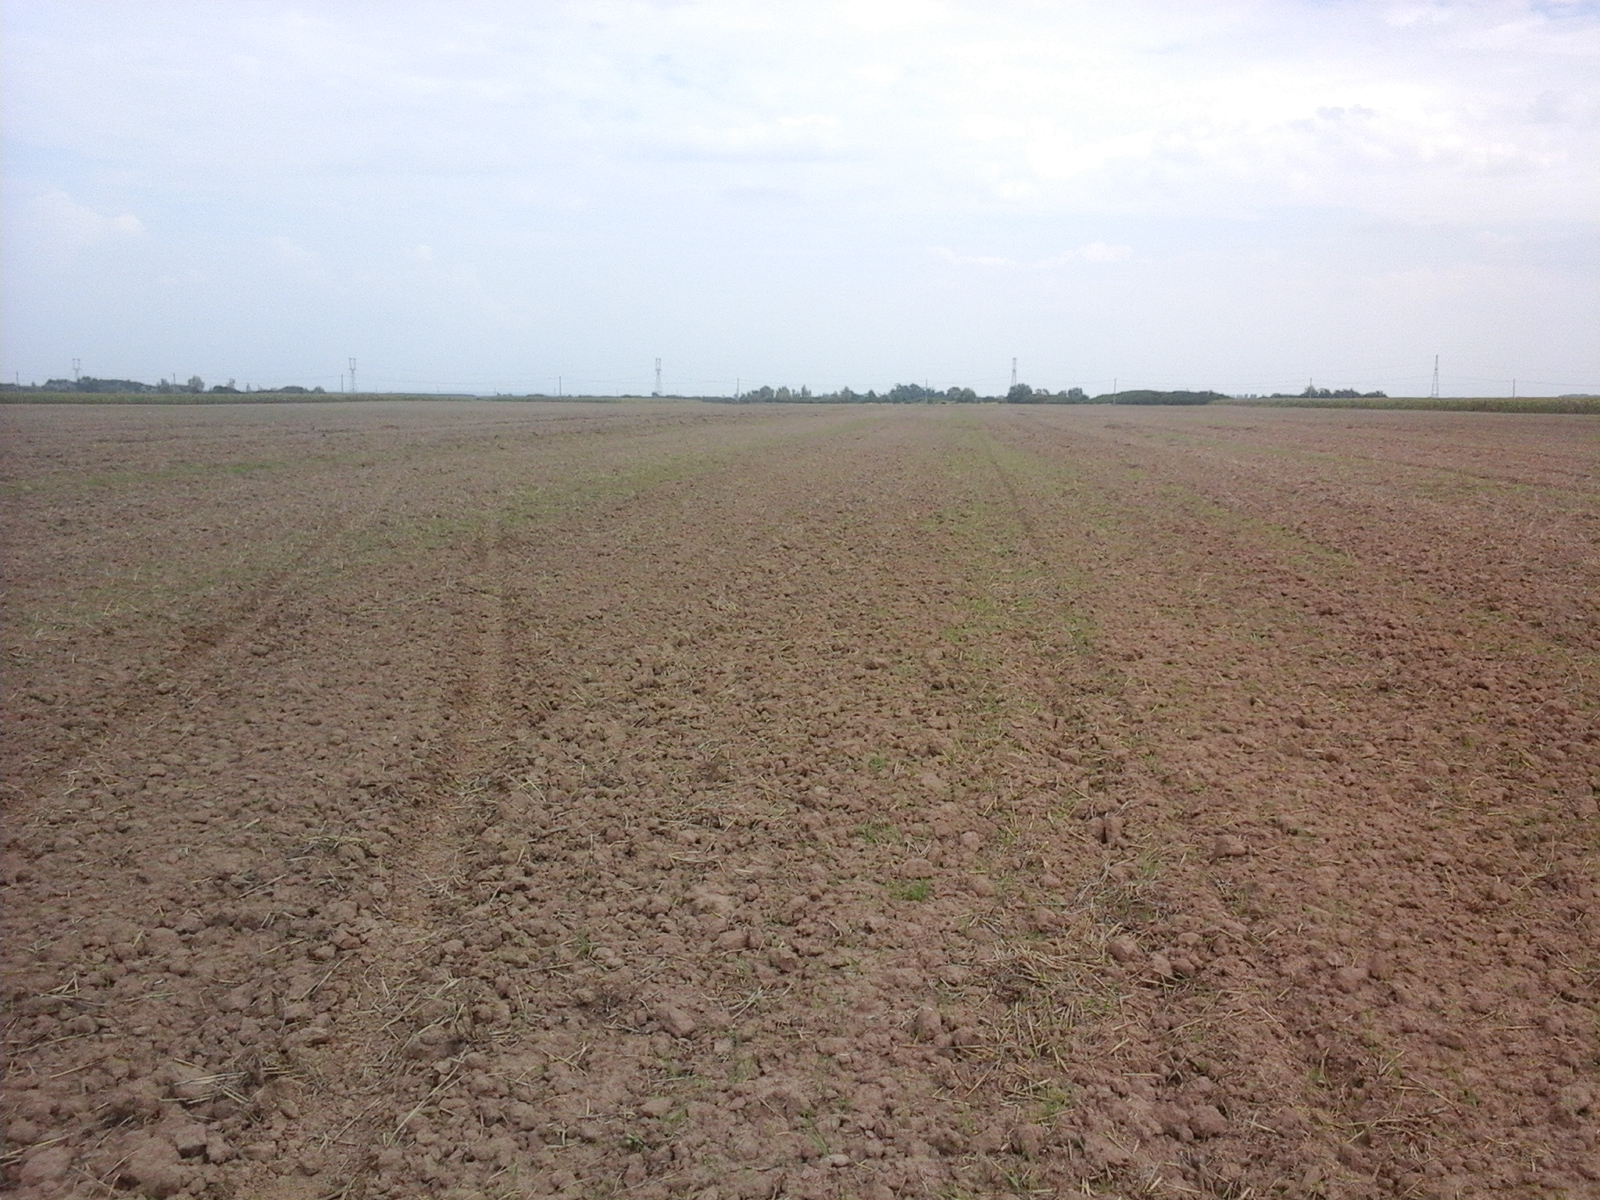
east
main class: Cropland
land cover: Common wheat
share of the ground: < 10 %
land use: Agriculture (excluding fallow land and kitchen gardens)
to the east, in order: Common wheat
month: August
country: RO
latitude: 46.7665
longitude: 21.6558
